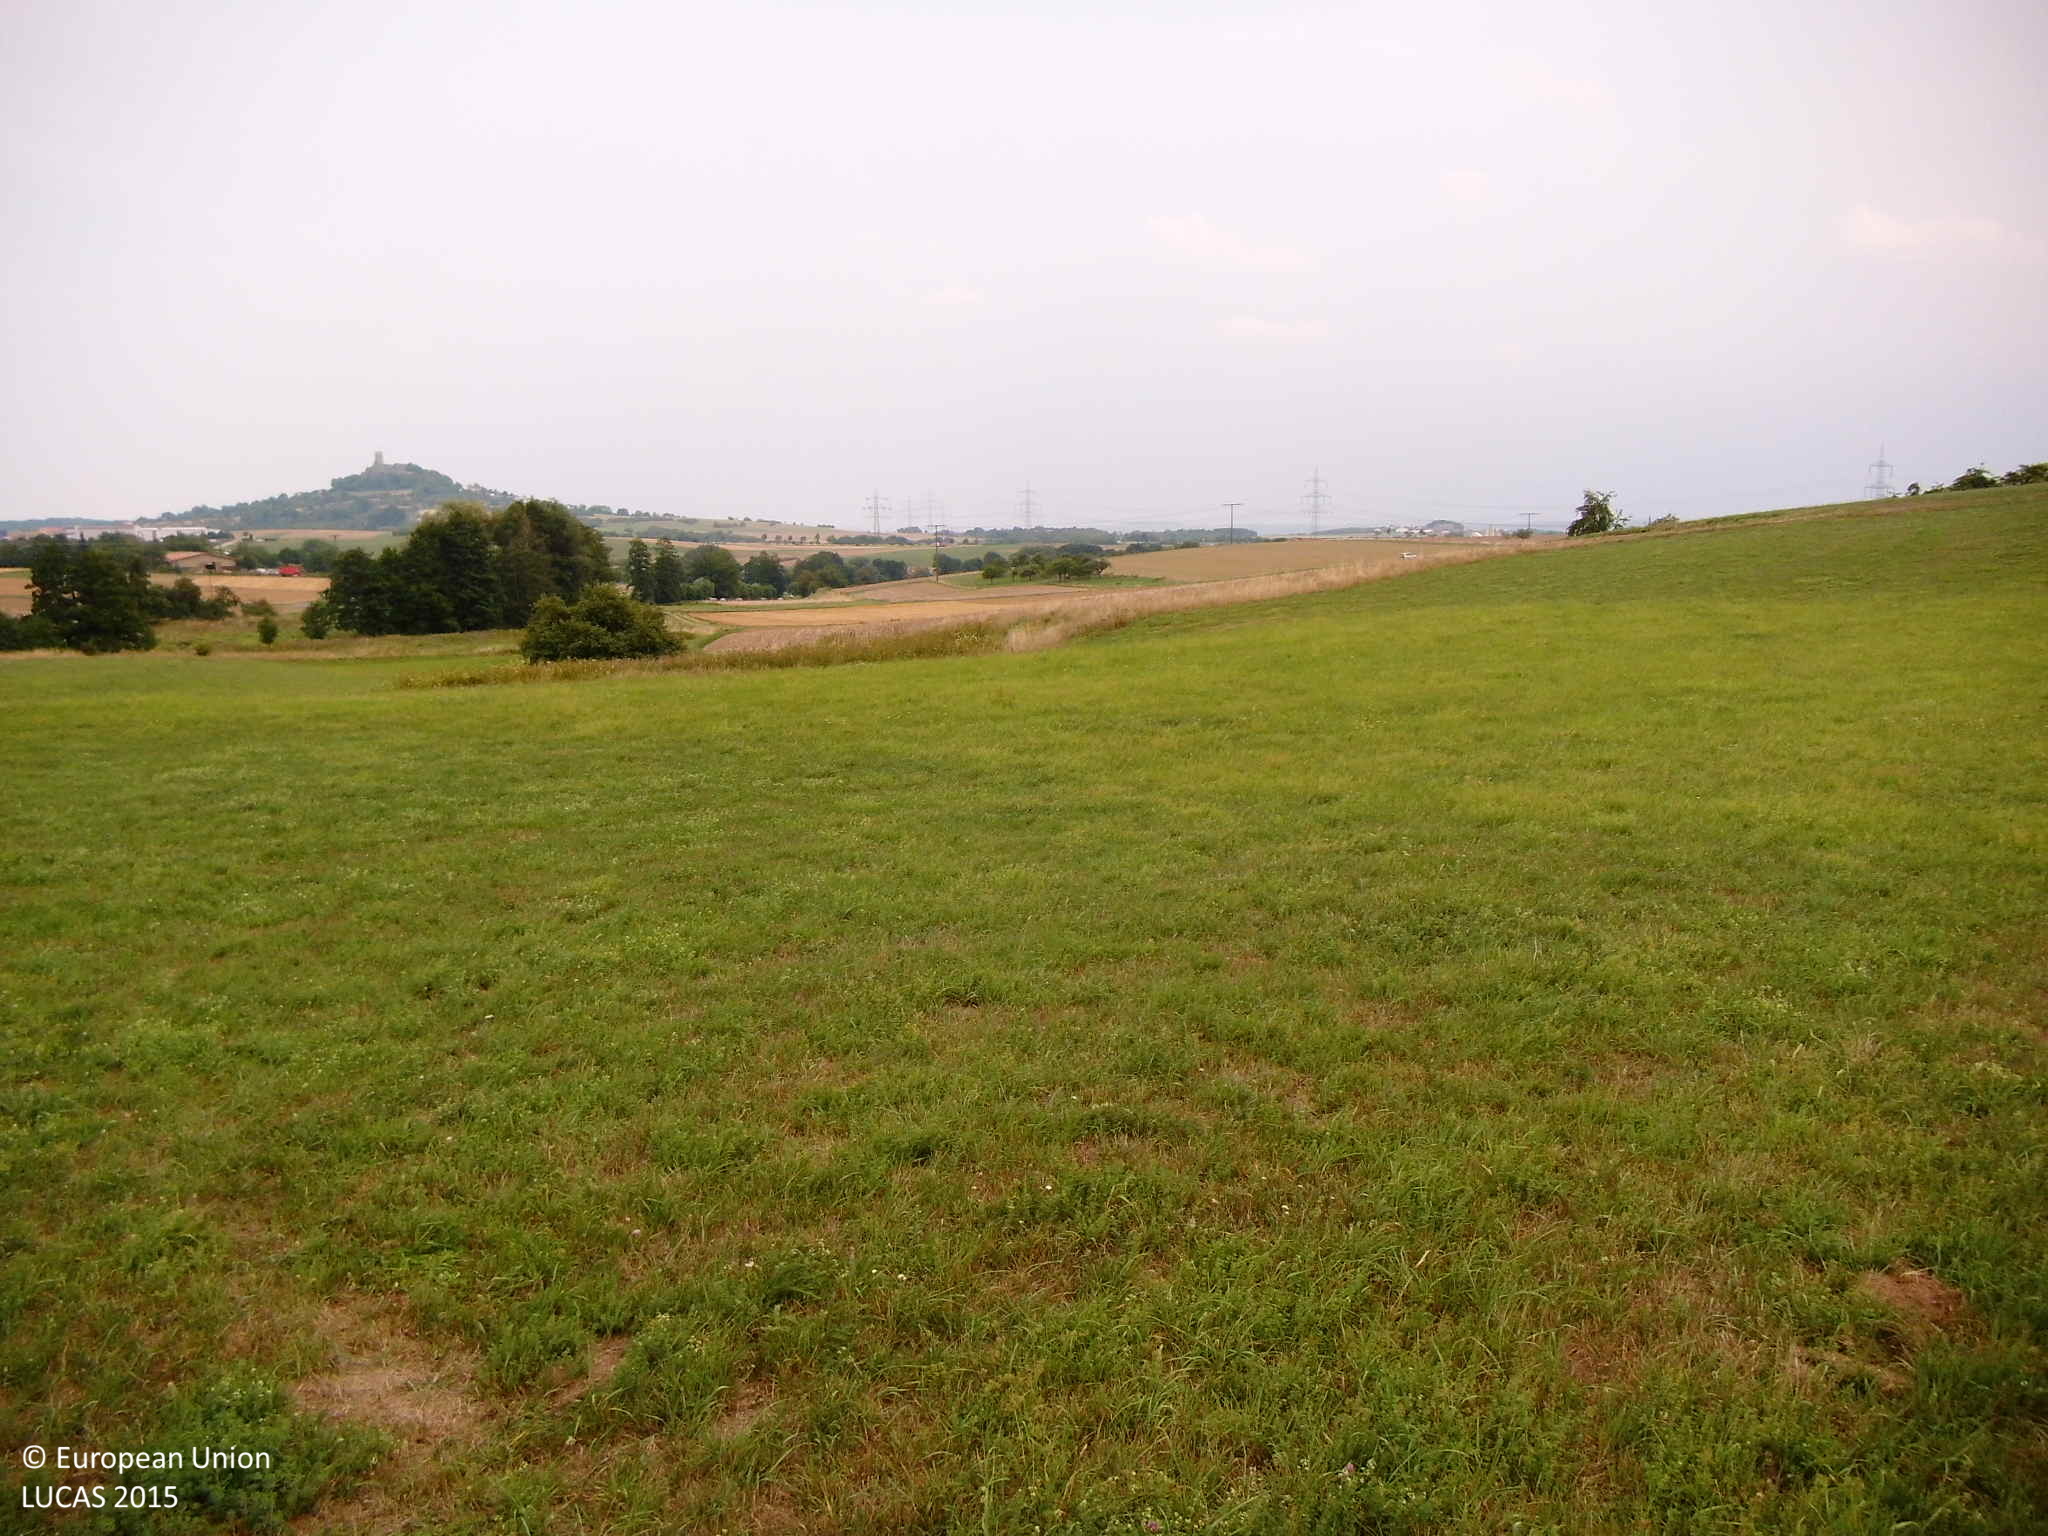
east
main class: Grassland
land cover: Grassland without tree/shrub cover
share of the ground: > 75 %
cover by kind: herbaceous plants 100 %
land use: Agriculture (excluding fallow land and kitchen gardens)
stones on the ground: < 10 %
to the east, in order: Grassland without tree/shrub cover; Shrubland without tree cover; Grassland without tree/shrub cover; Rape and turnip rape; Tracks; Ditches and canals; Common wheat
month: August
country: DE
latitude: 50.6073
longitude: 8.6014
